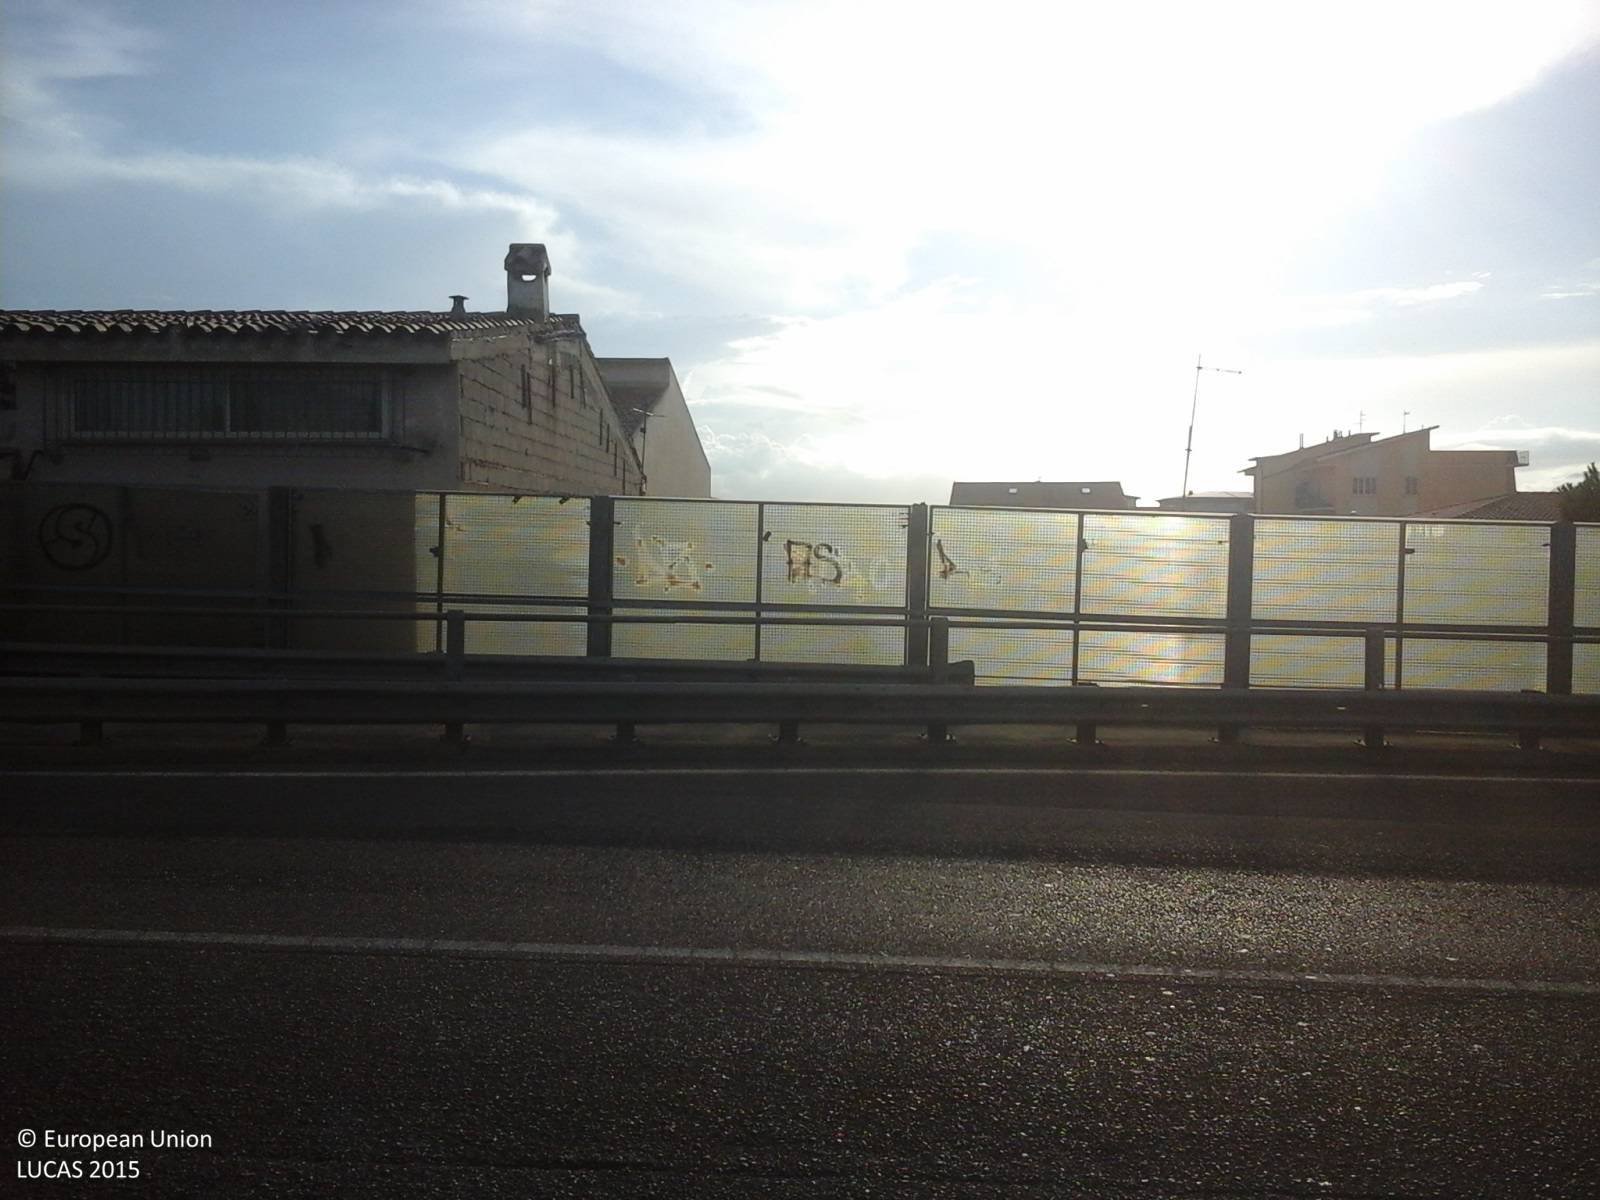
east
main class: Grassland
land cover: Grassland without tree/shrub cover
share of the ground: > 75 %
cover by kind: herbaceous plants 90 %, unconsolidated bare surface 10 %
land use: Community services
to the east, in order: Grassland without tree/shrub cover; Artificial constructions in urban areas
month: August
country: IT
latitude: 40.9175
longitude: 9.4918
